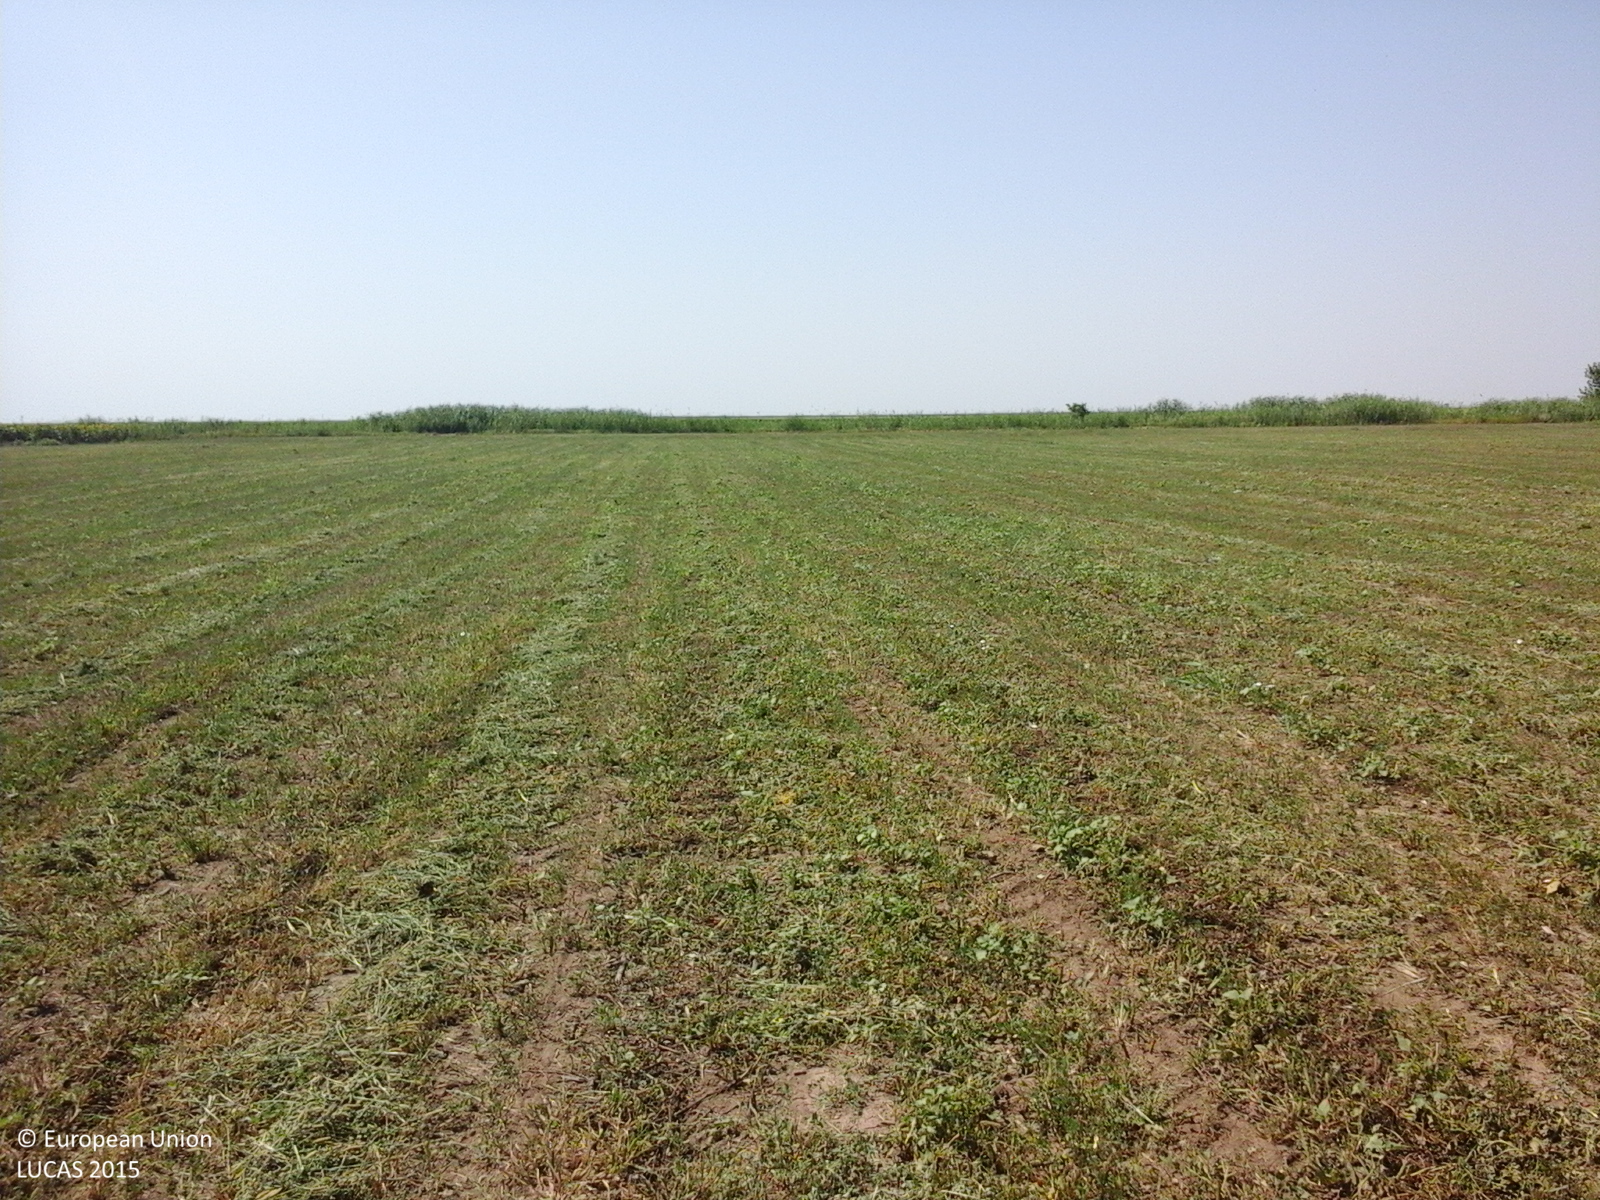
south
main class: Cropland
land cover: Lucerne
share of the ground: 25 - 50 %
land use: Agriculture (excluding fallow land and kitchen gardens)
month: July
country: RO
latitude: 45.0609
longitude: 27.2738
